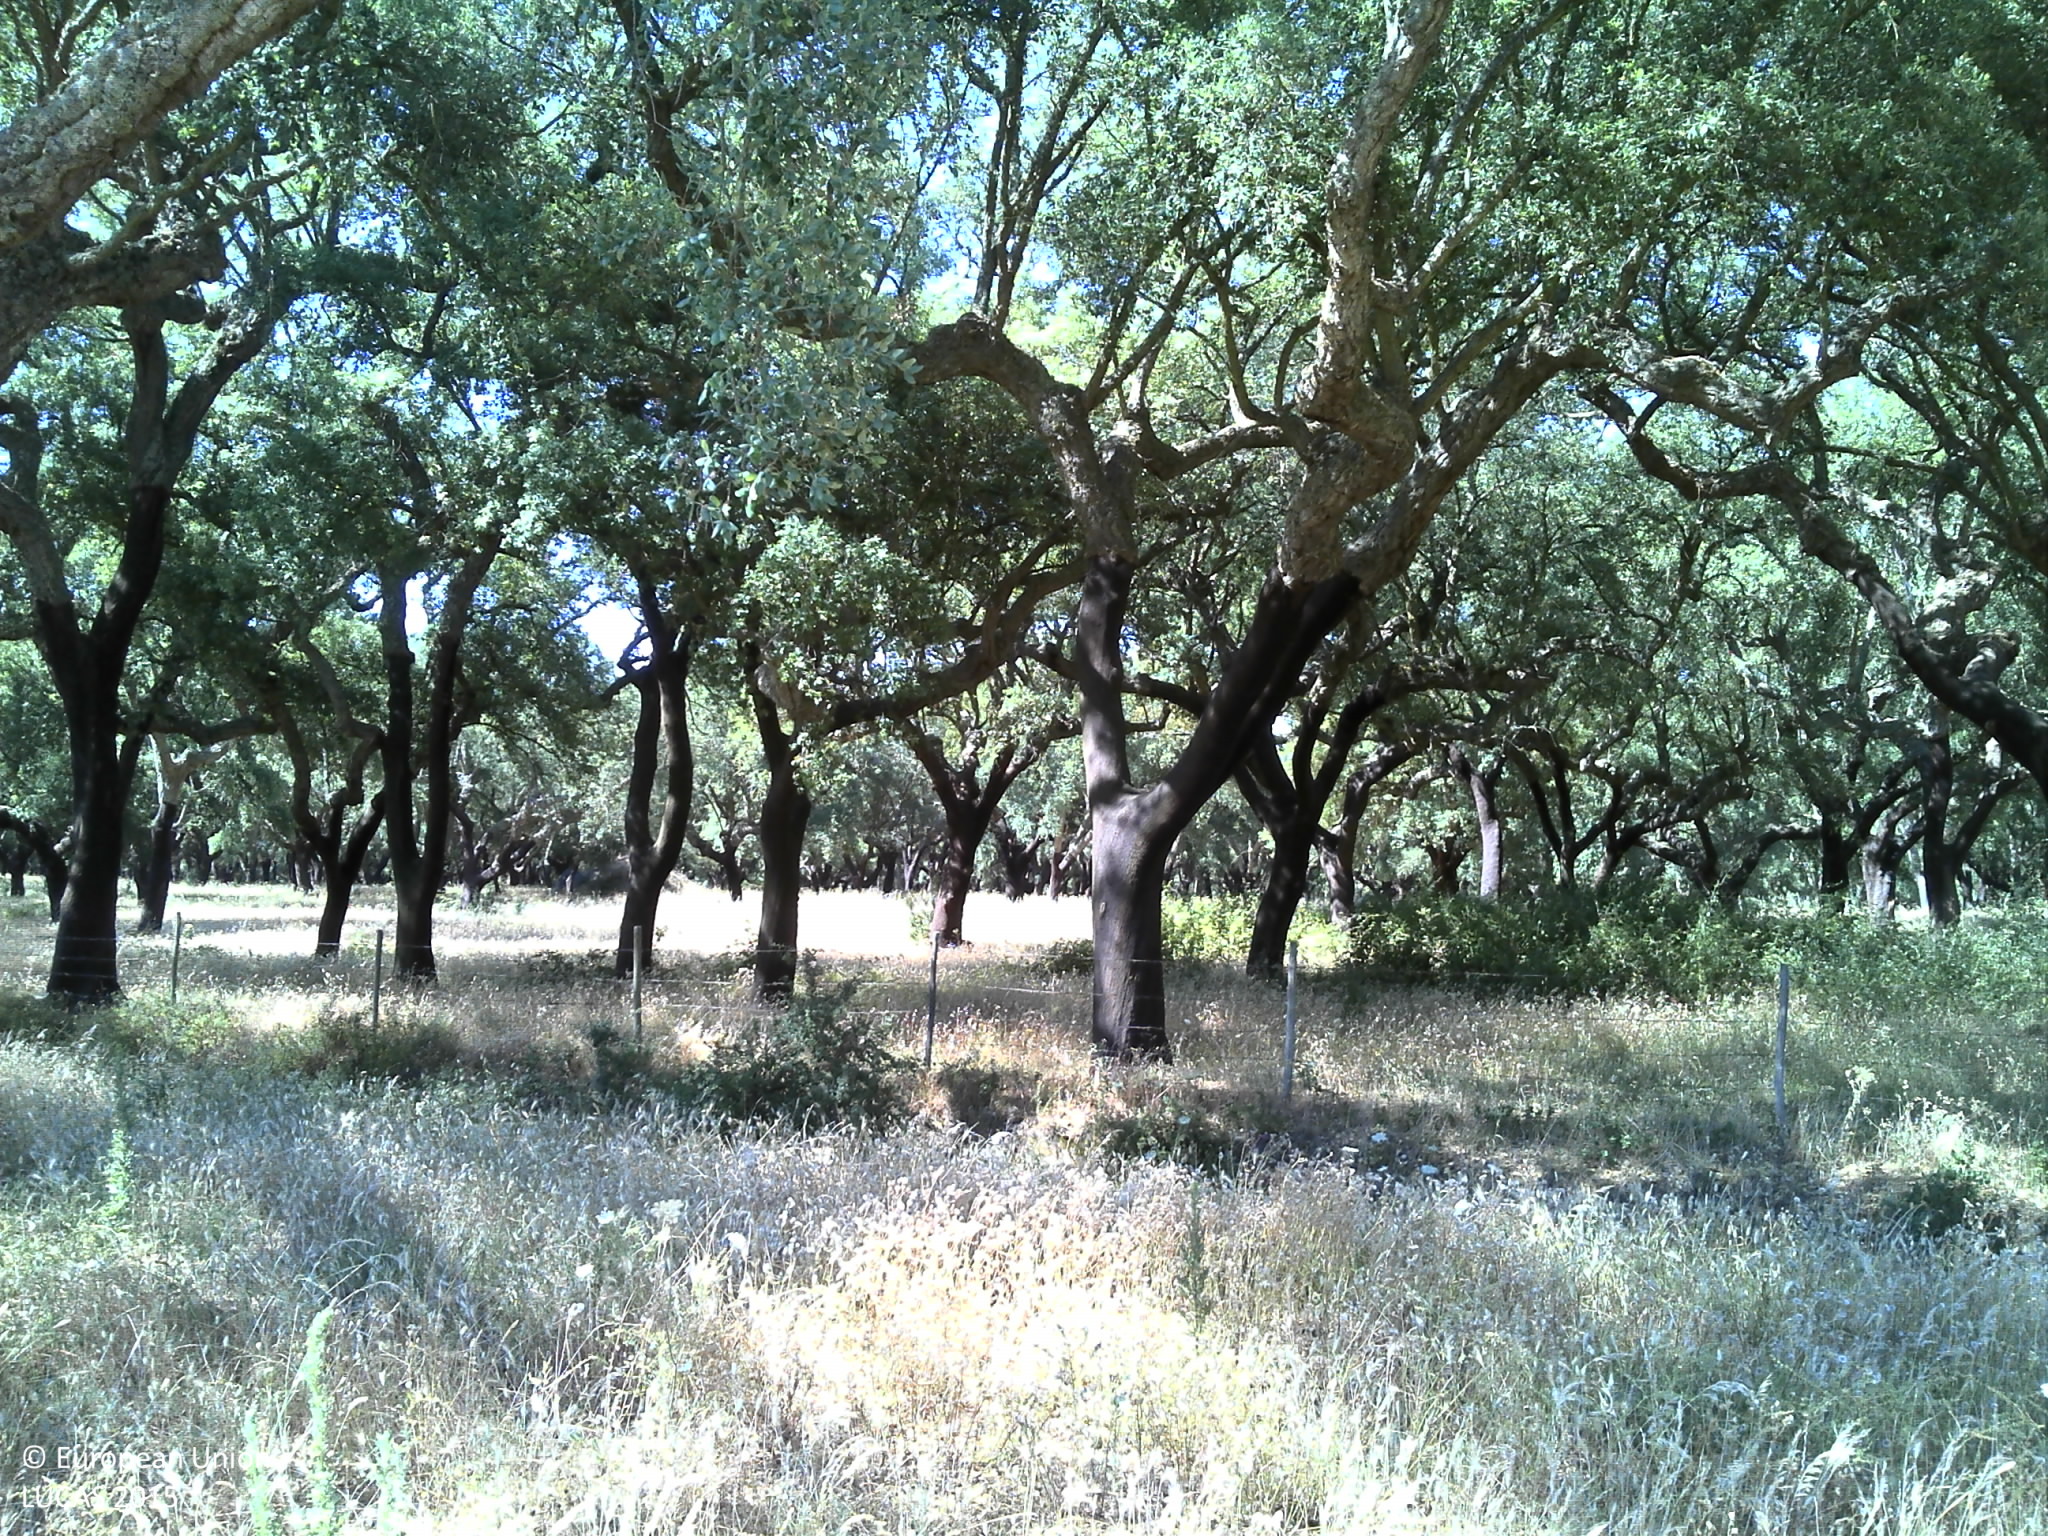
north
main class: Woodland
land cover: Broadleaved woodland
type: broadleaved evergreen forest
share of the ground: > 75 %
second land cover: Grassland without tree/shrub cover
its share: 50 - 75 %
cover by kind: broadleaved forest trees 75 %, herbaceous plants 25 %
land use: Forestry
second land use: Agriculture (excluding fallow land and kitchen gardens)
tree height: > 5 m
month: June
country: PT
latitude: 38.6827
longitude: -8.1767
